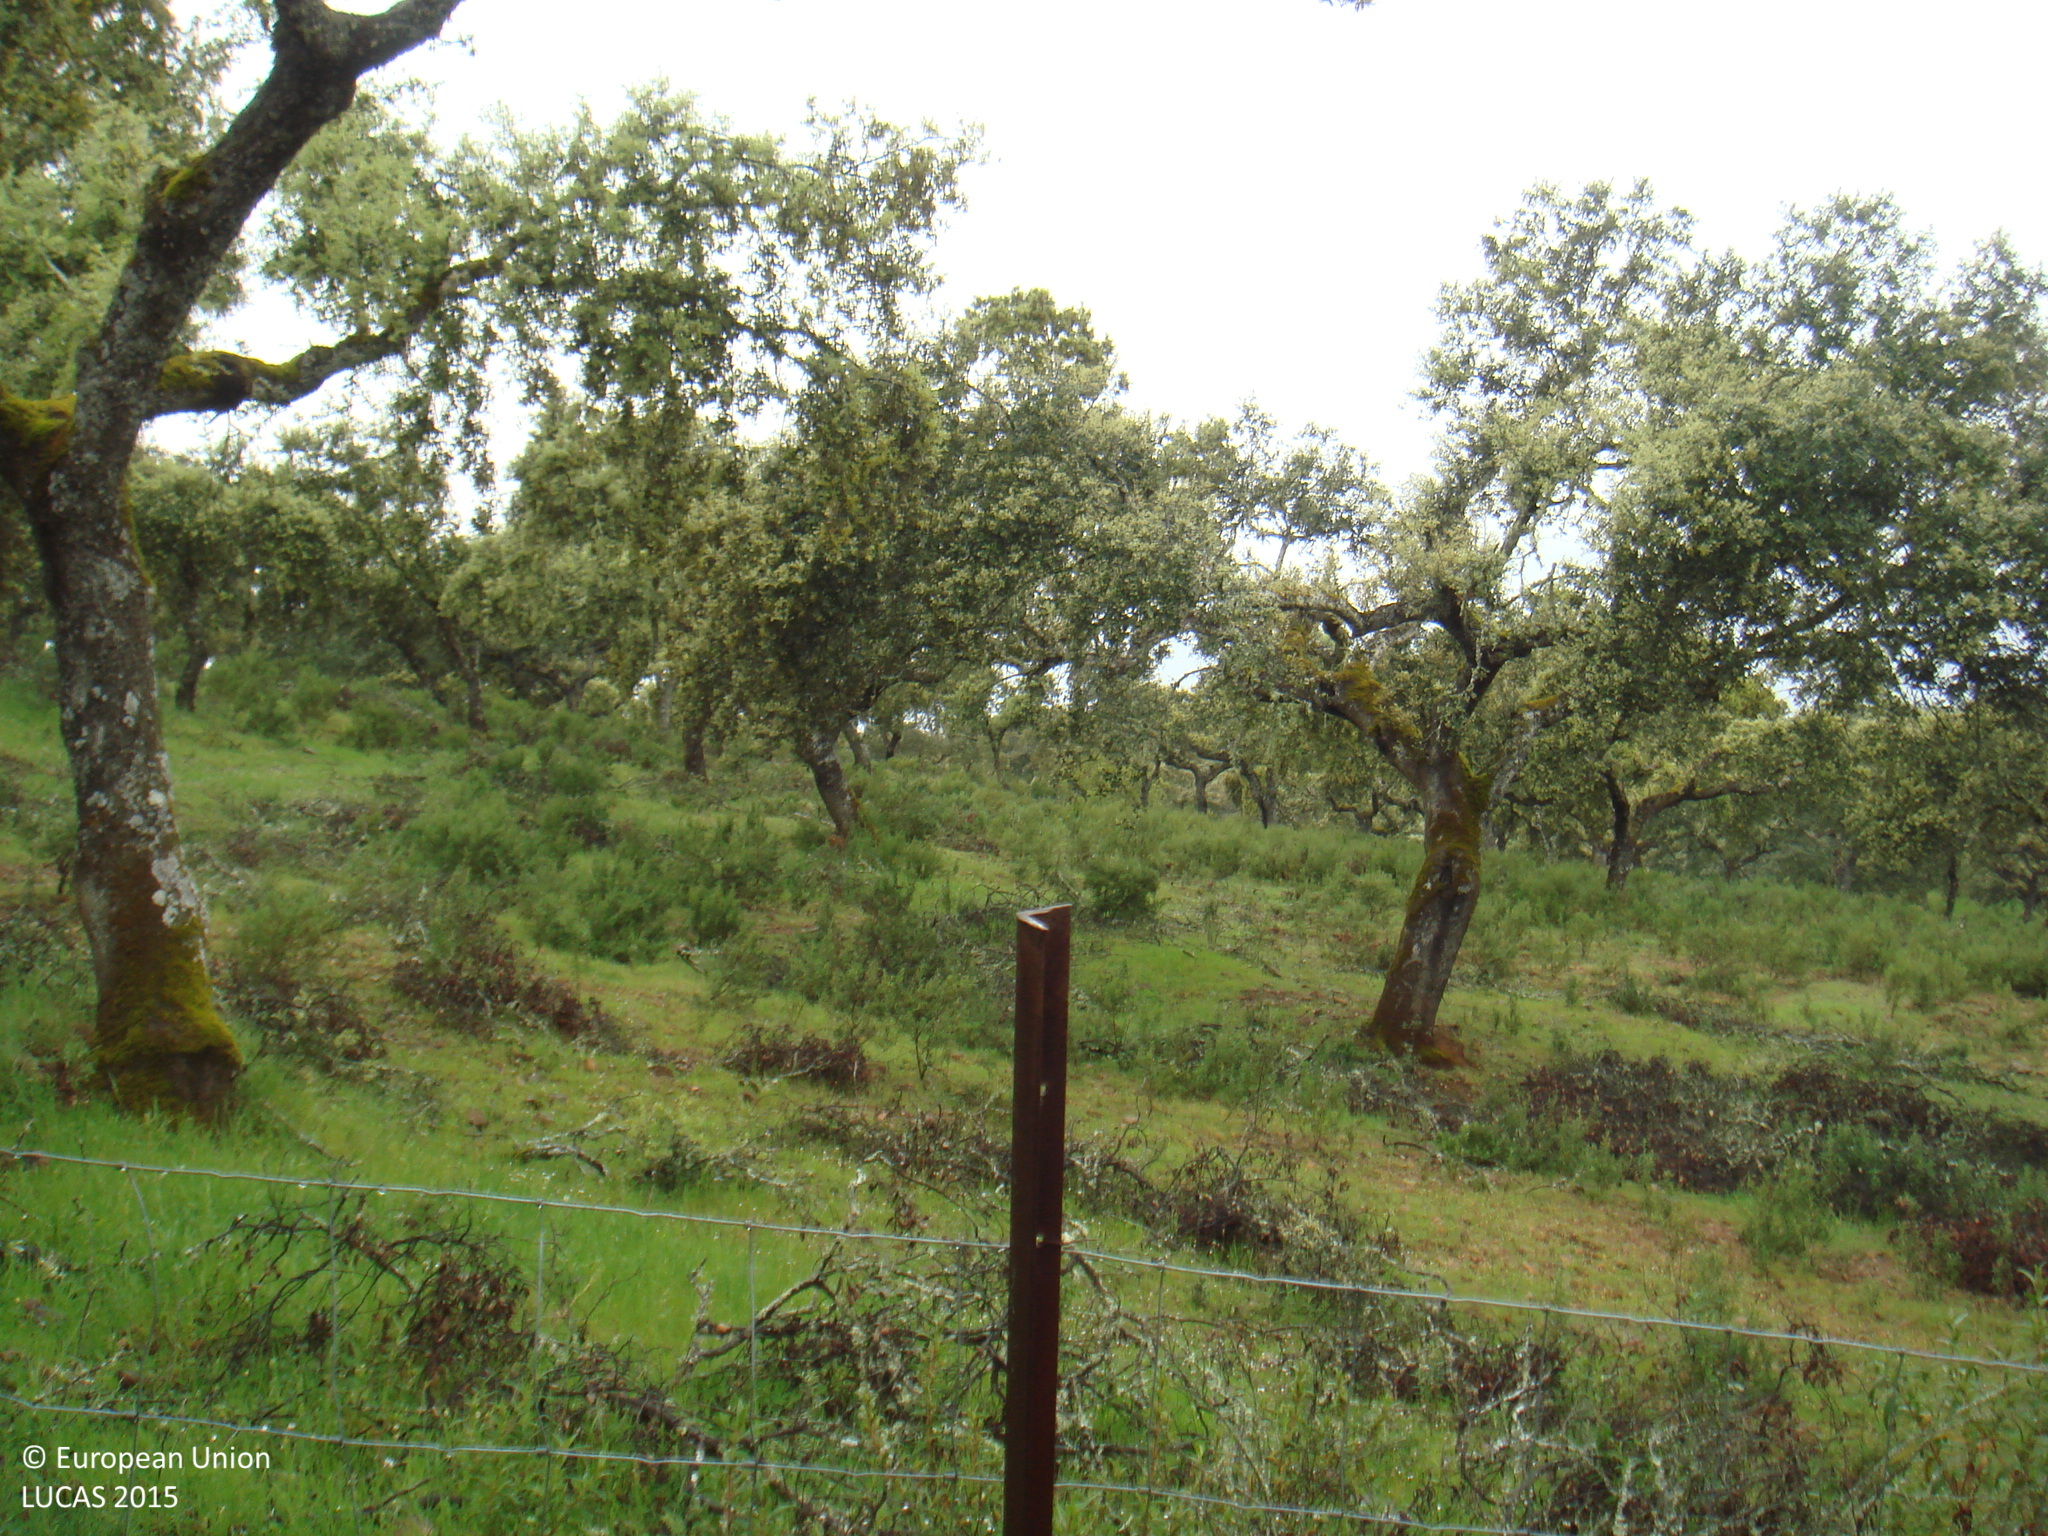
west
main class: Woodland
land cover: Broadleaved woodland
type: broadleaved evergreen forest
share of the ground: 50 - 75 %
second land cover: Spontaneously vegetated surfaces
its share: 50 - 75 %
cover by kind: broadleaved forest trees 60 %, herbaceous plants 30 %, shrubs 10 %
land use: Forestry
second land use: Agriculture (excluding fallow land and kitchen gardens)
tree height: > 5 m
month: April
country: ES
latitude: 38.1925
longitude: -5.3159
